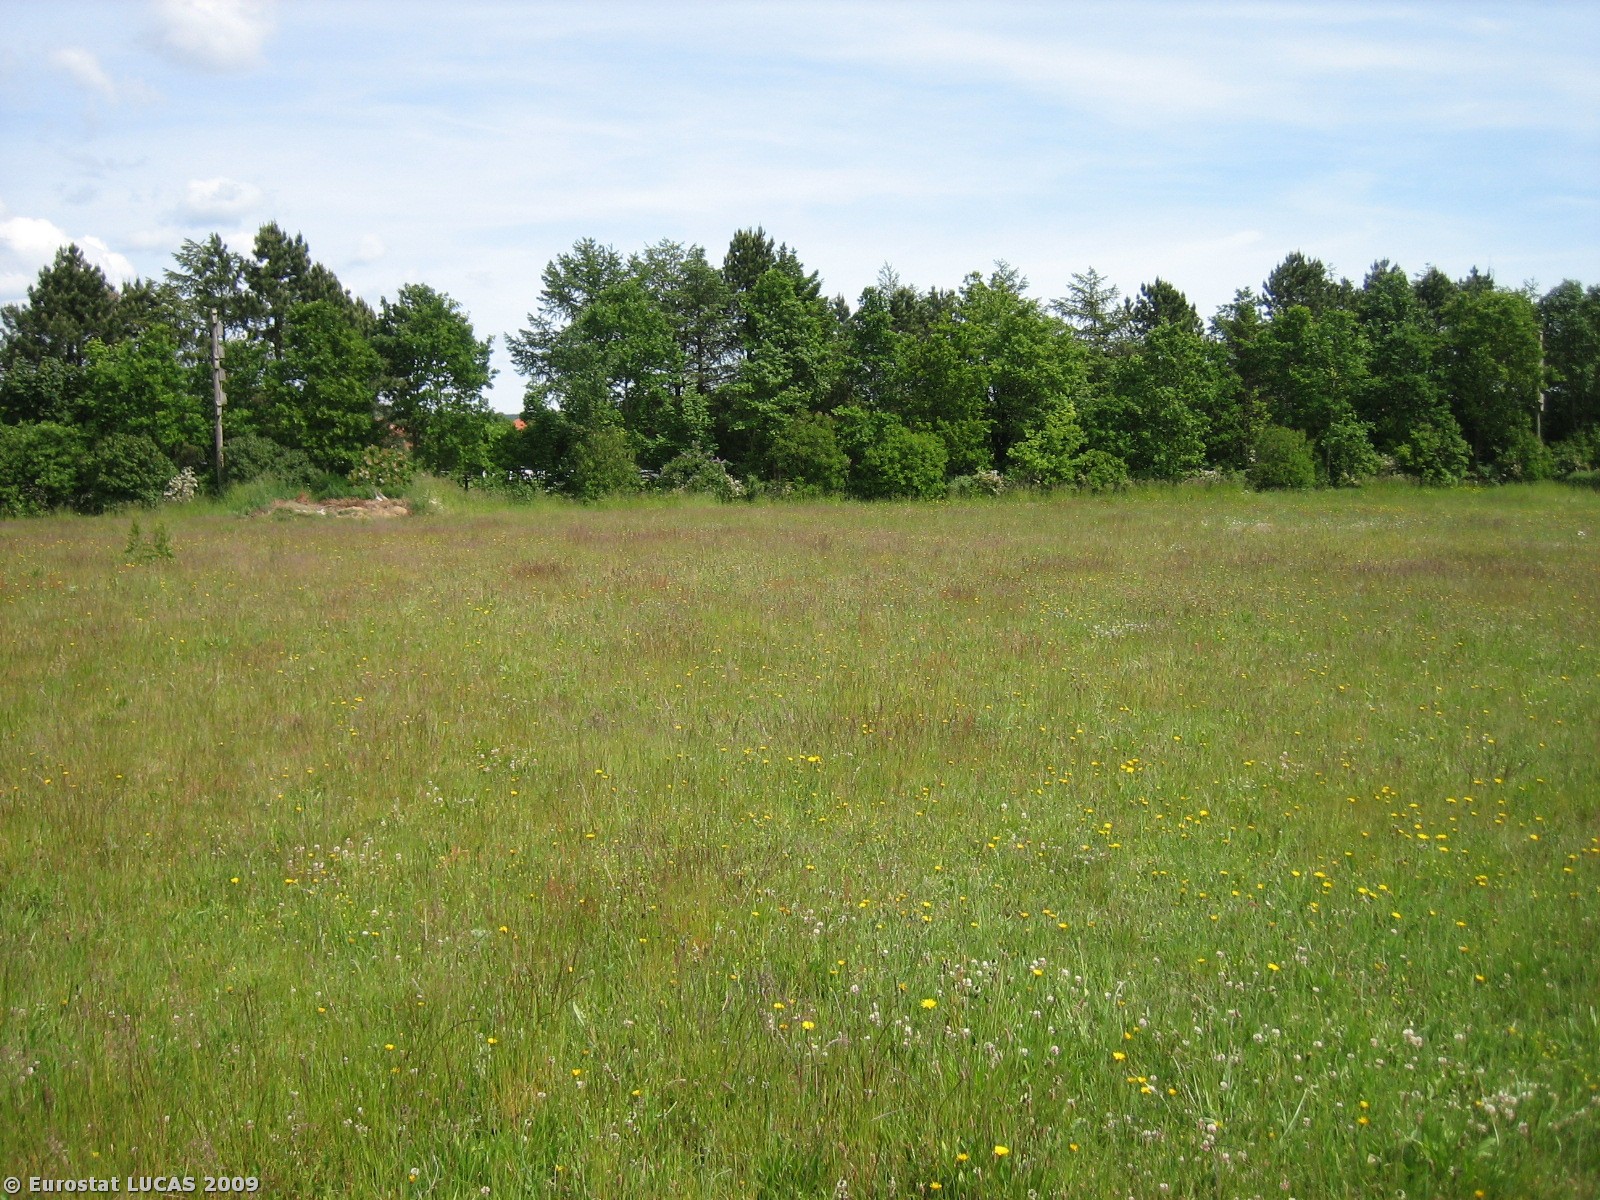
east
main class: Grassland
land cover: Grassland without tree/shrub cover
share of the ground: > 75 %
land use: Unused
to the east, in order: Grassland without tree/shrub cover; Tracks; Grassland without tree/shrub cover; Mixed woodland; Grassland without tree/shrub cover; Fences; Grassland without tree/shrub cover; Fences; Grassland without tree/shrub cover; Tracks; Broadleaved woodland; Grassland without tree/shrub cover
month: June
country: DK
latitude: 56.1874
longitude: 9.6942
